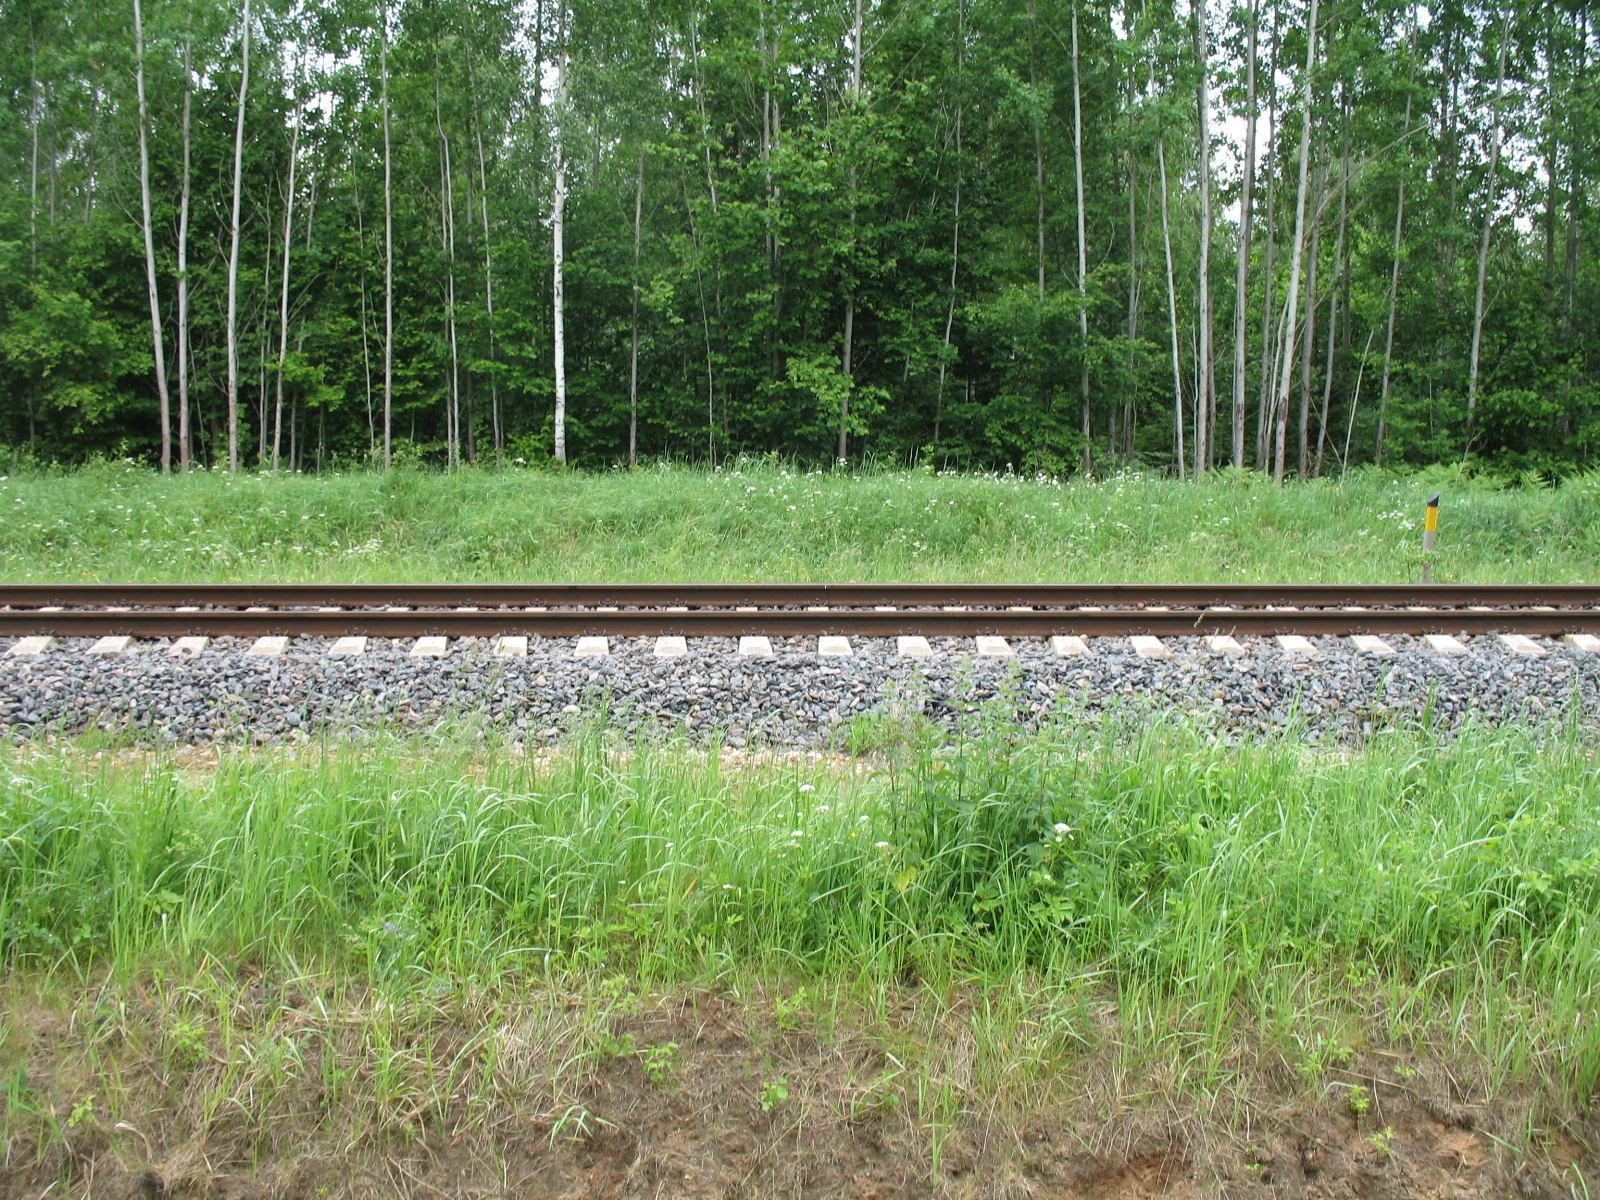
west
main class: Grassland
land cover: Spontaneously vegetated surfaces
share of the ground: 50 - 75 %
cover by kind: herbaceous plants 60 %, unconsolidated bare surface 40 %
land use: Railway transport
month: June
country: LV
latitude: 56.3835
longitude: 23.6670
